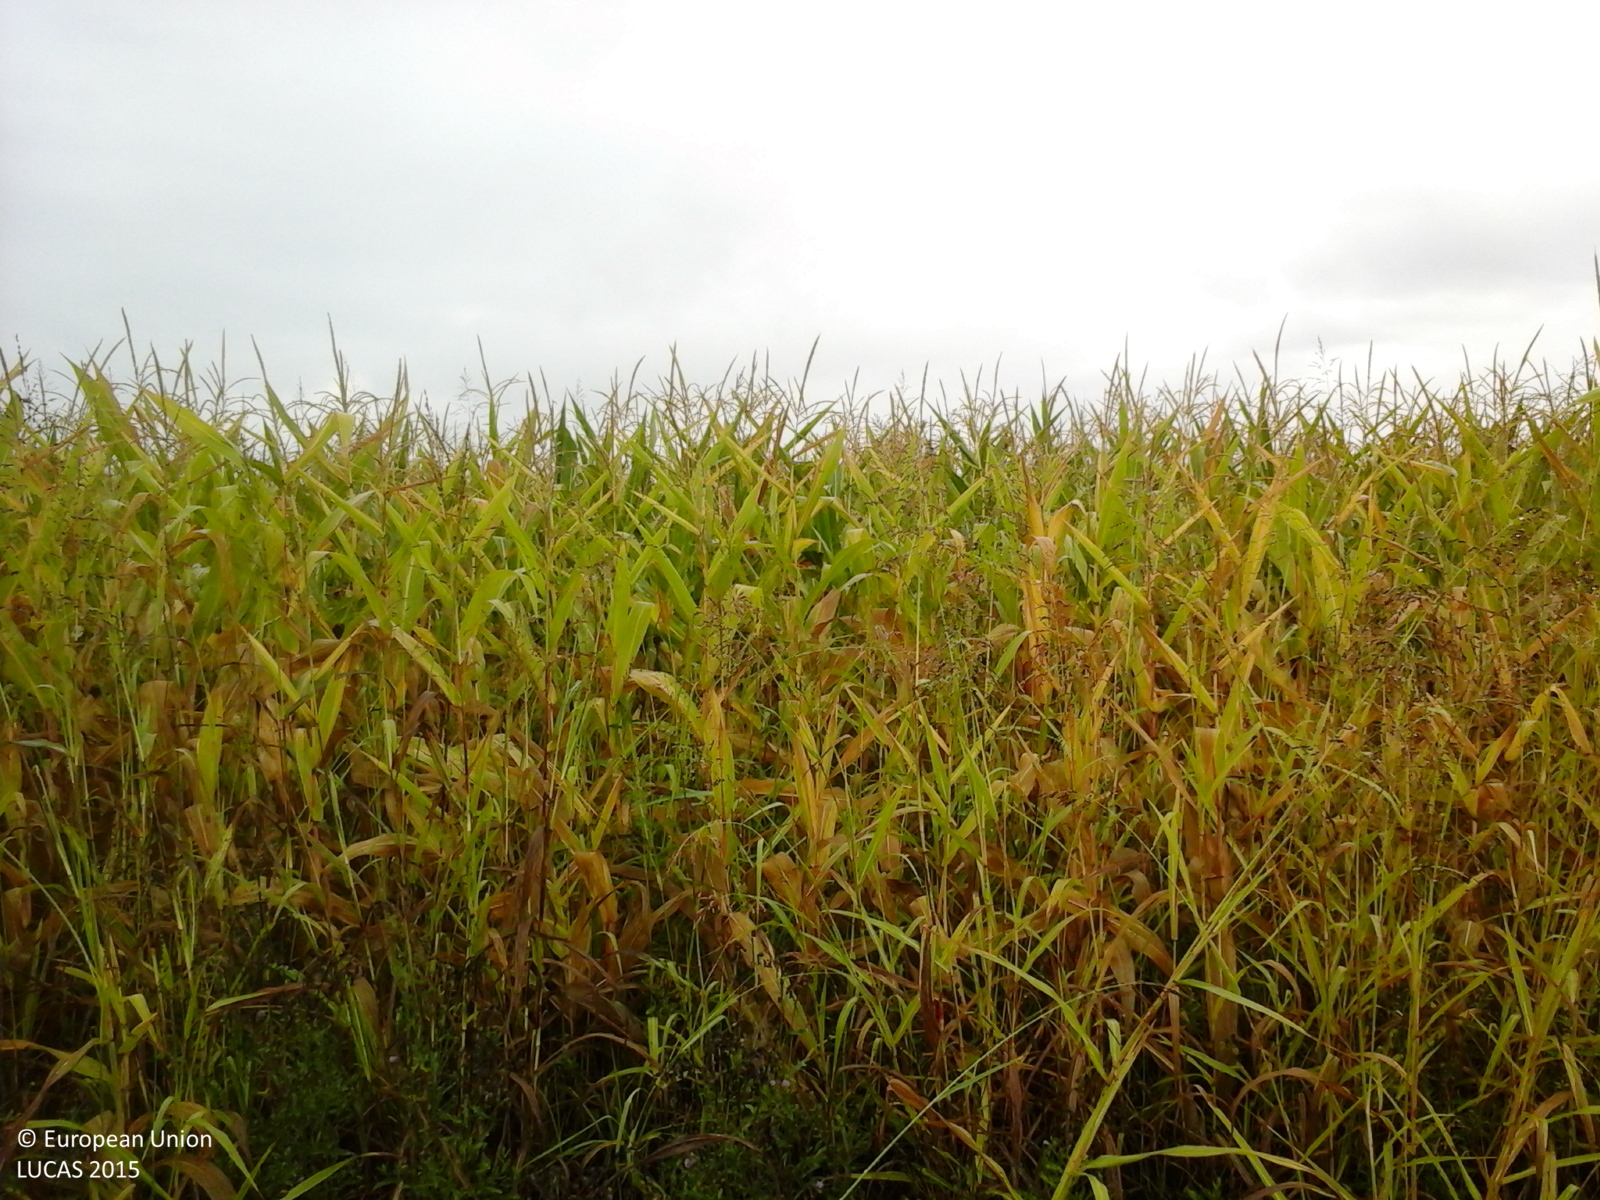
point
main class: Cropland
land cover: Maize
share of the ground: > 75 %
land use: Agriculture (excluding fallow land and kitchen gardens)
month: August
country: RO
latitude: 45.9356
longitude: 20.7441
